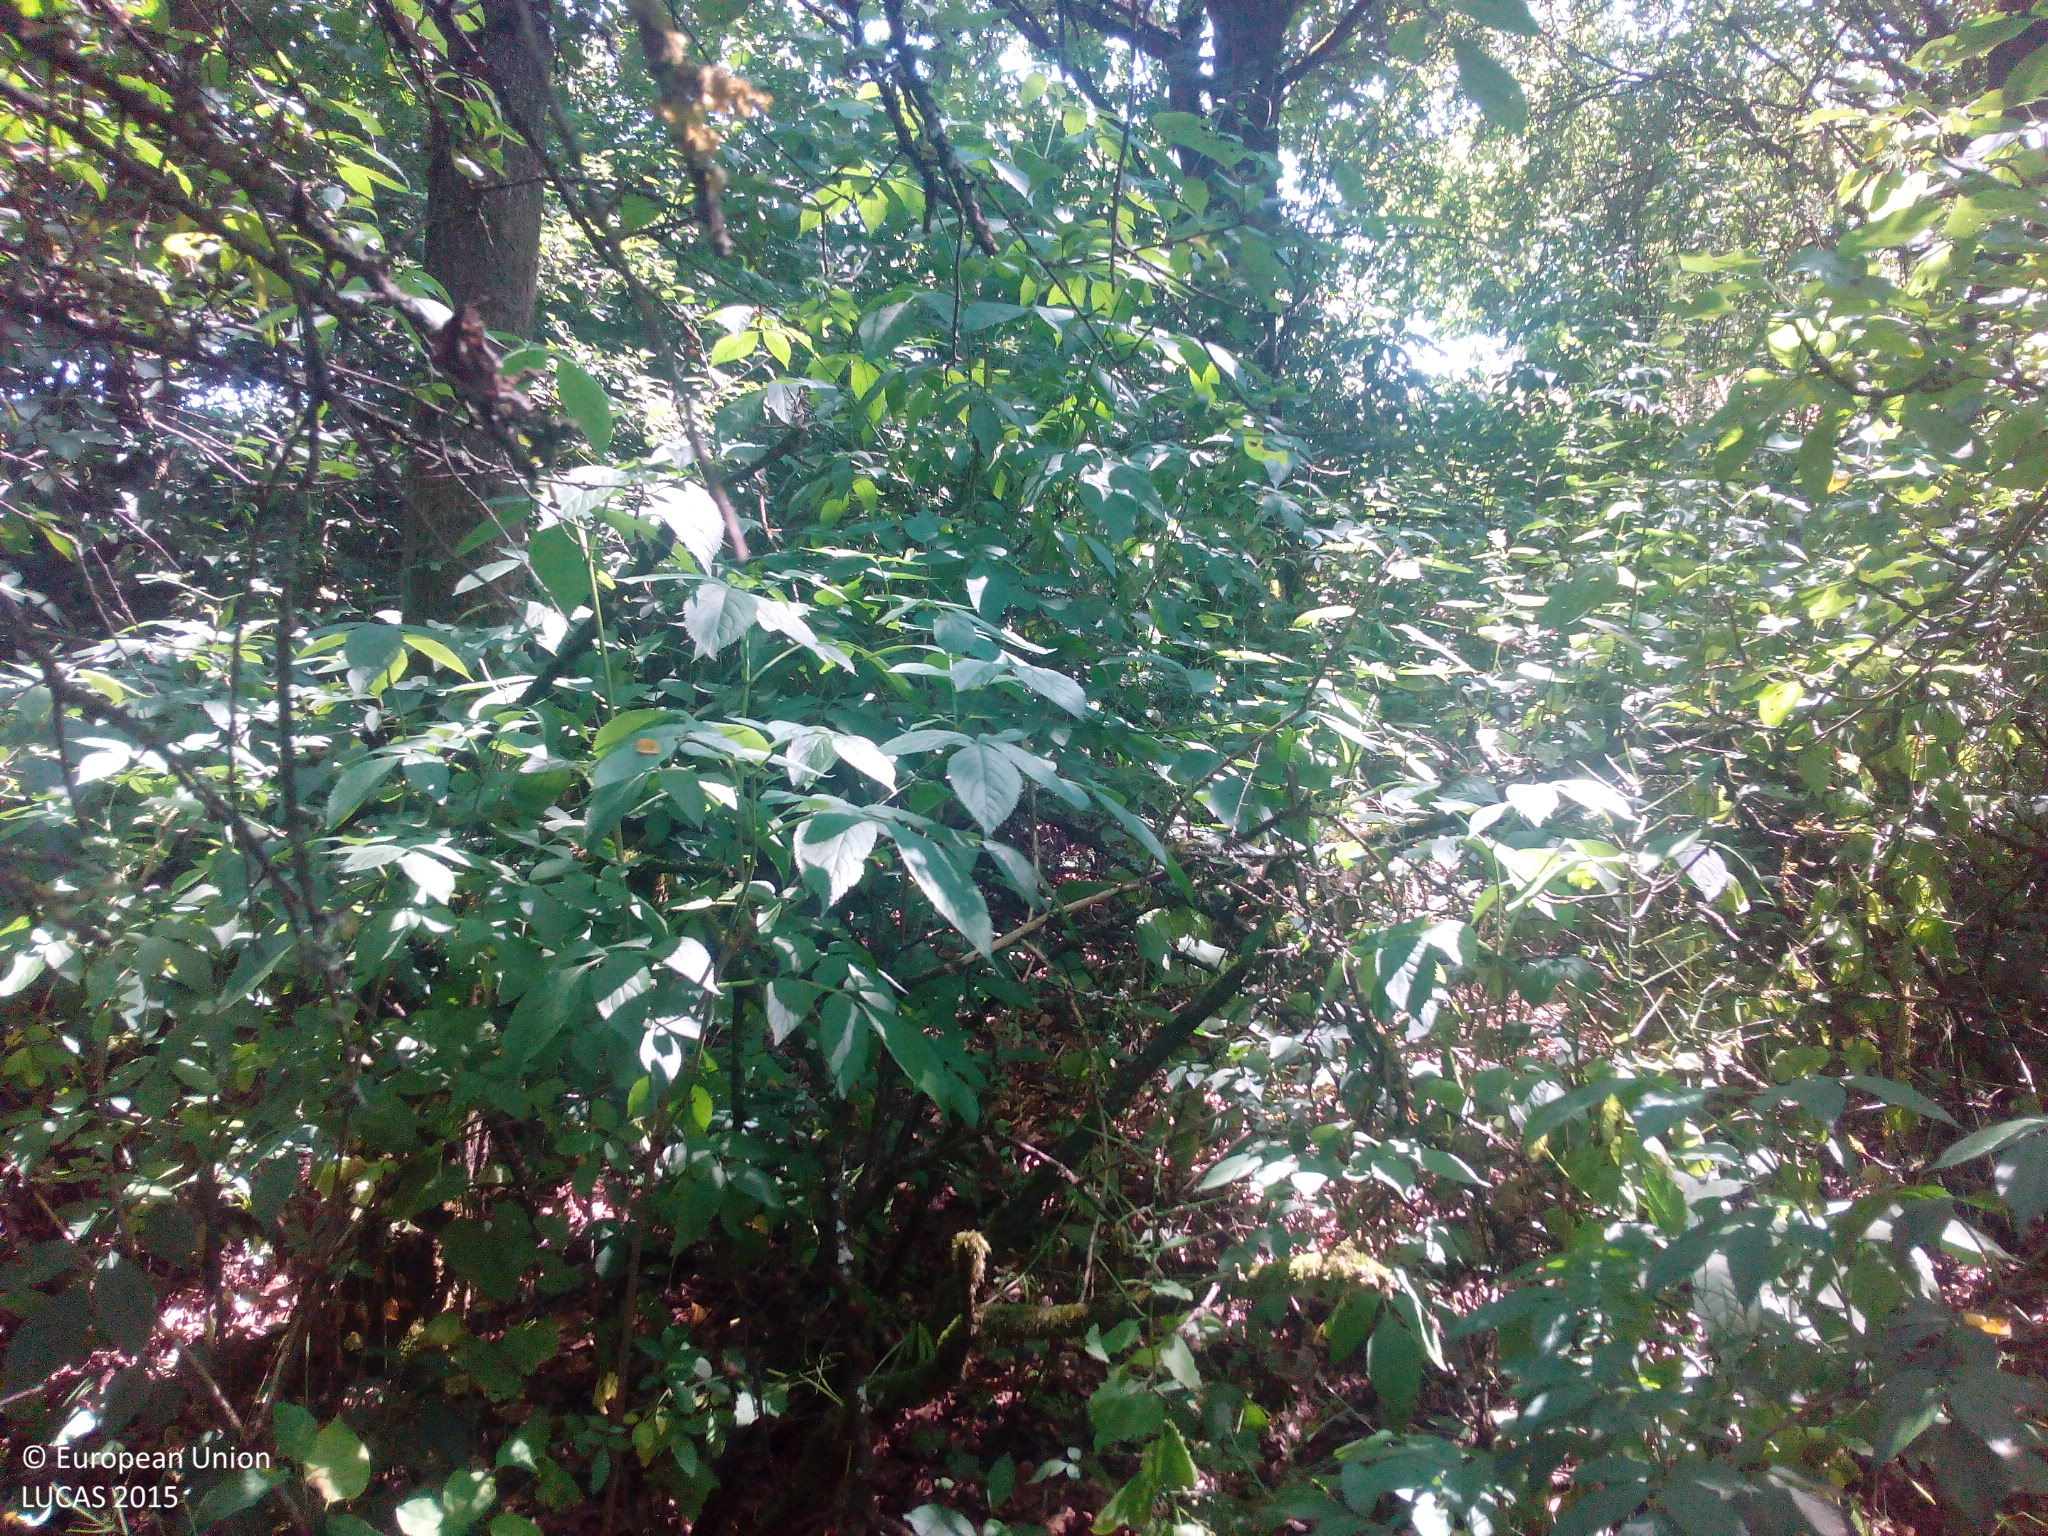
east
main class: Woodland
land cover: Broadleaved woodland
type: mesophytic deciduous forest
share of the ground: > 75 %
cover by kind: broadleaved forest trees 90 %, herbaceous plants 10 %
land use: Semi-natural and natural areas not in use
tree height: > 5 m
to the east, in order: Broadleaved woodland; Grassland without tree/shrub cover; Tracks; Grass margins; Ditches and canals; Grass margins; Maize; Electric lines; Maize
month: July
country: DE
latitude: 50.1285
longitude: 10.6293
